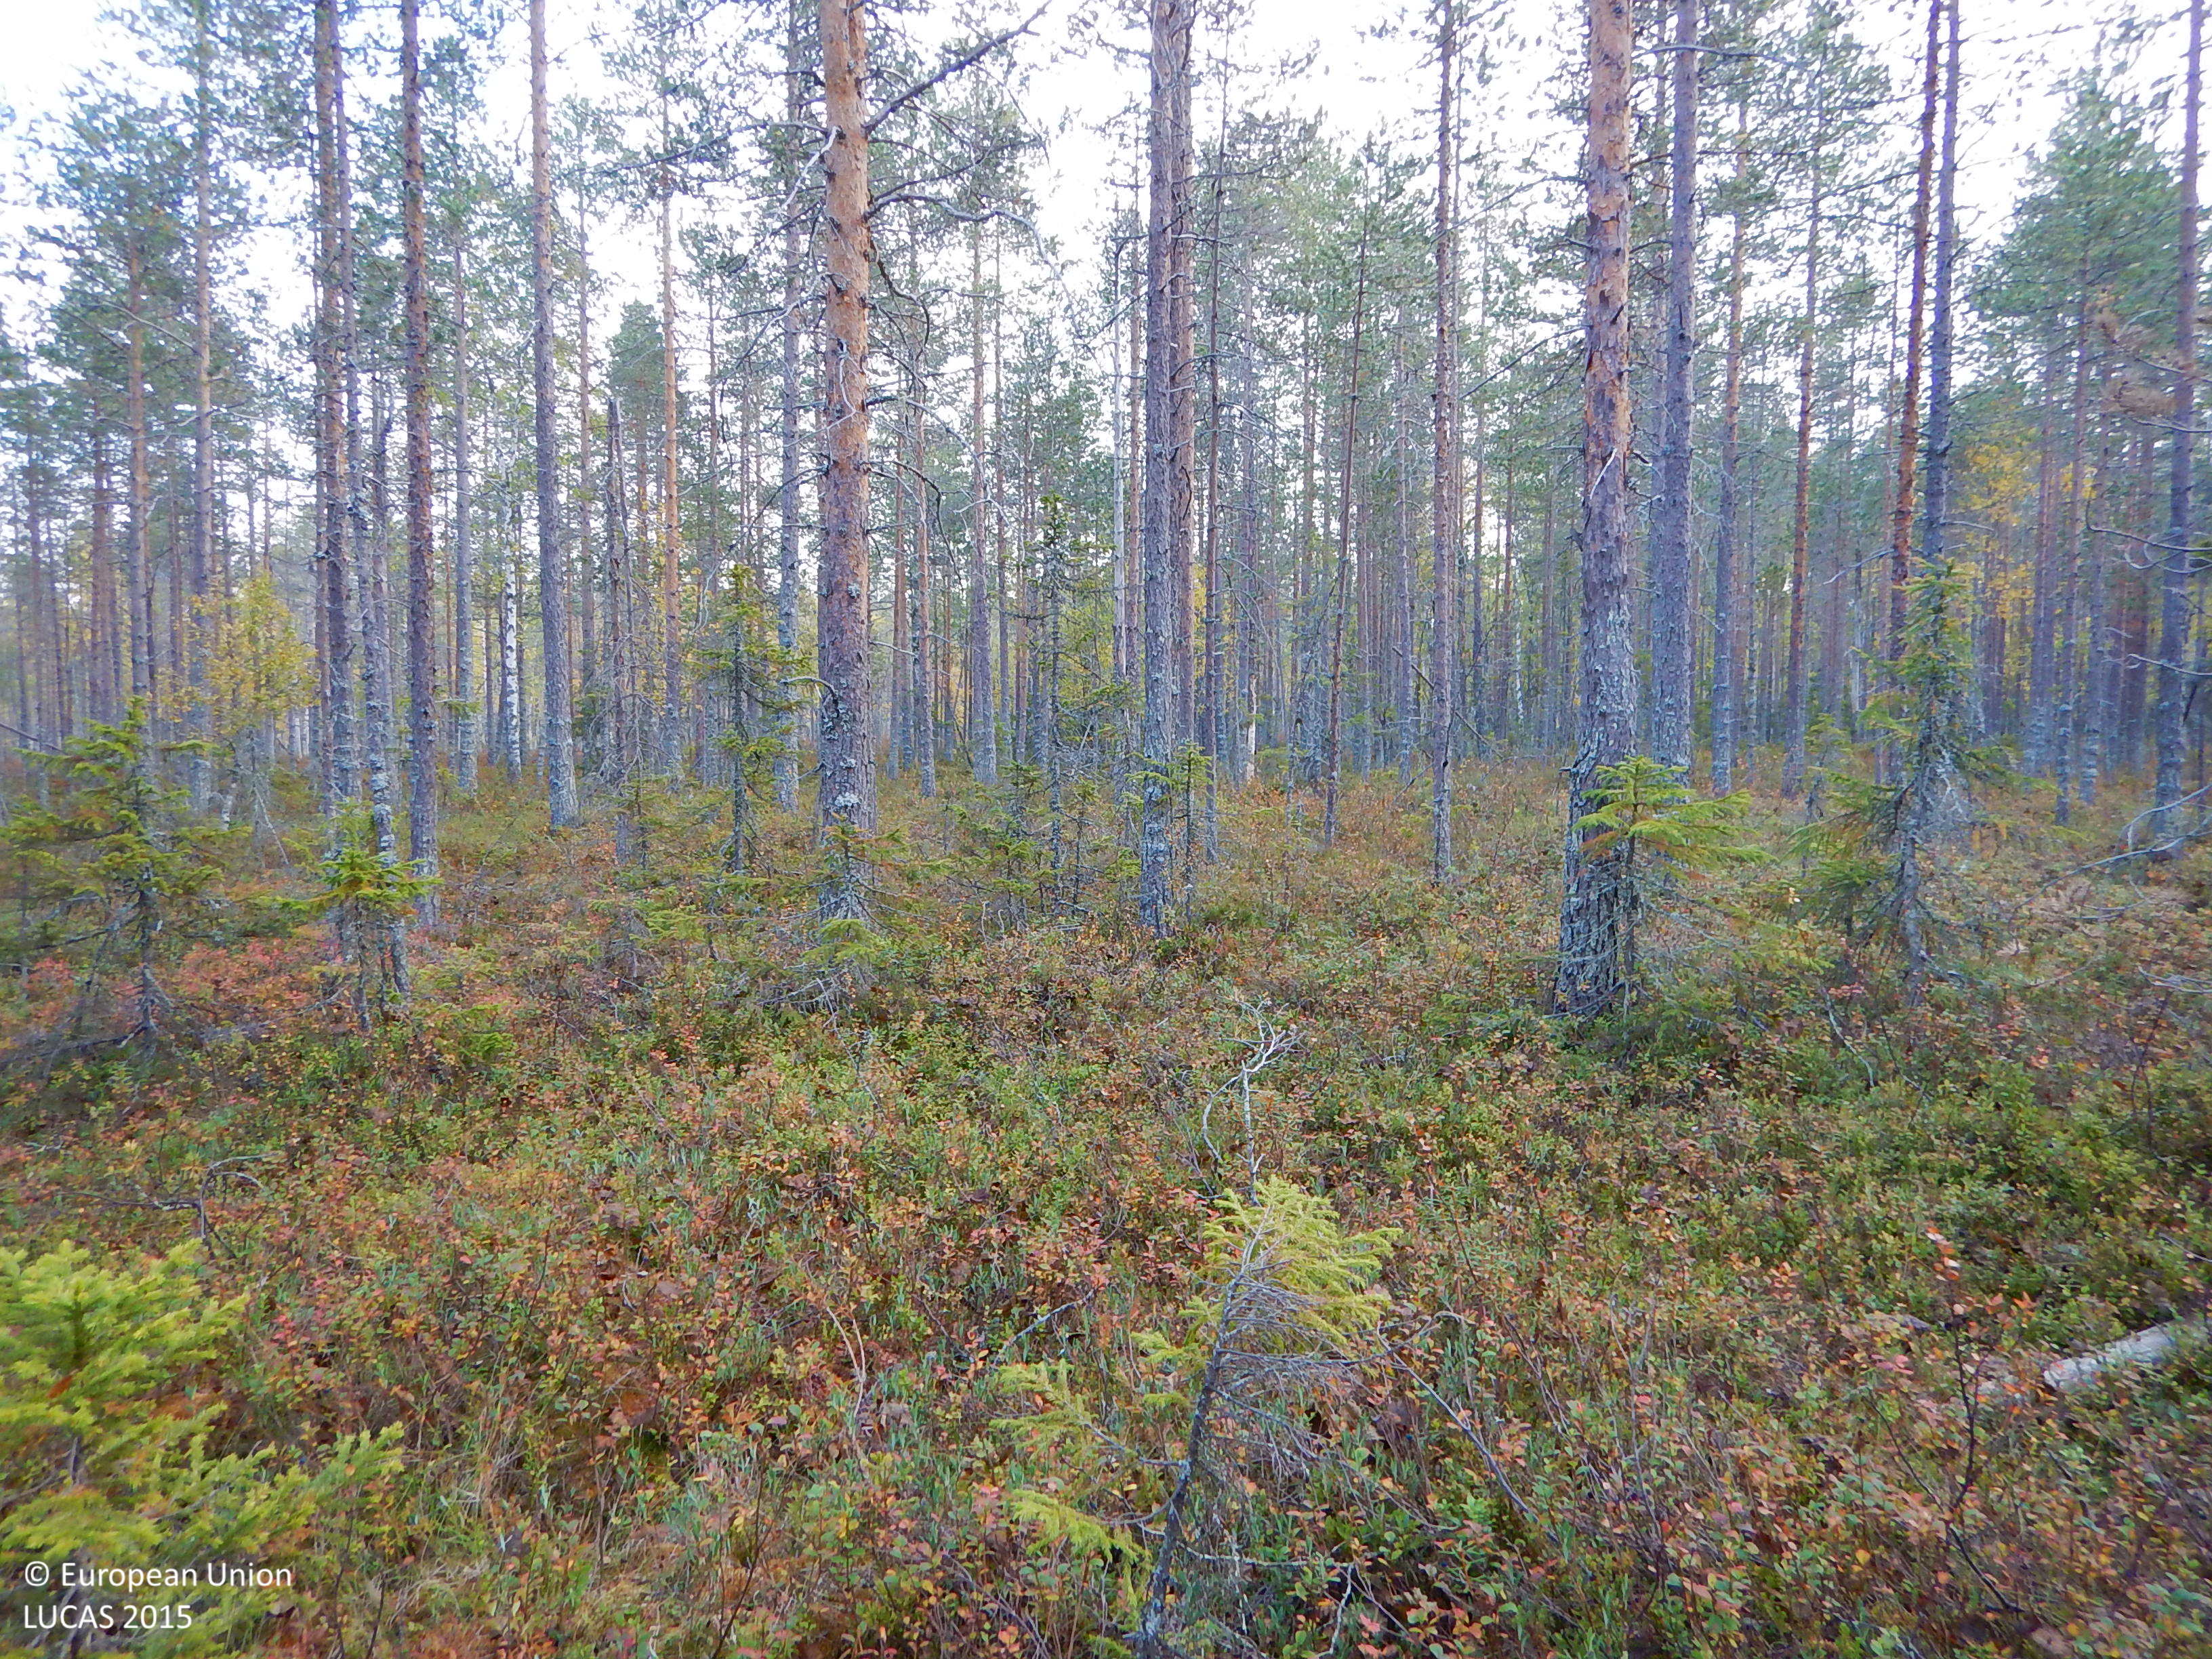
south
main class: Woodland
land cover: Pine dominated coniferous woodland
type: boreal forest
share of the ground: 25 - 50 %
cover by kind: coniferous forest trees 35 %, shrubs 25 %, lichens and mosses 20 %, herbaceous plants 15 %, broadleaved forest trees 5 %
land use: Forestry
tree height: > 5 m
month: September
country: SE
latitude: 64.6750
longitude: 20.1352
